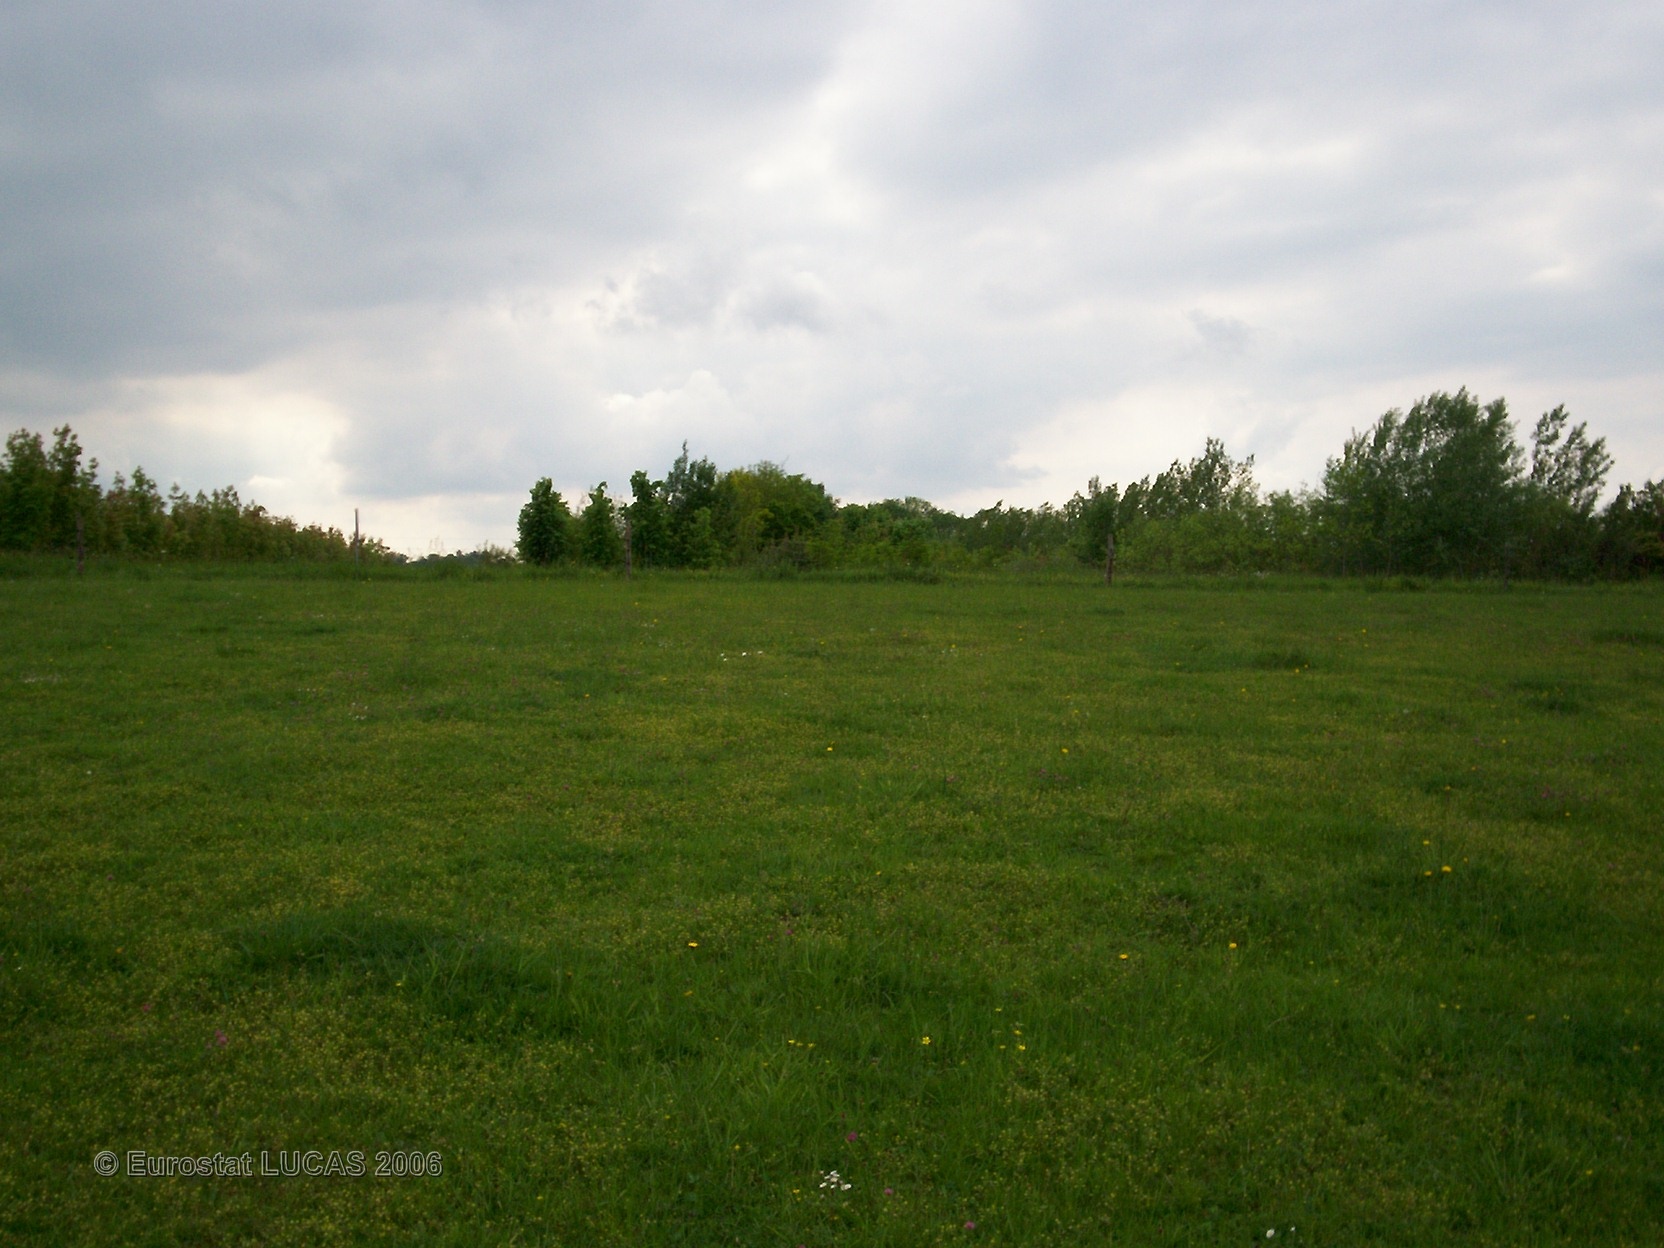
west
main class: Grassland
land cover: Grassland without tree/shrub cover
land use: Agriculture (excluding fallow land and kitchen gardens)
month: May
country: FR
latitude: 45.7697
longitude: 0.5604
